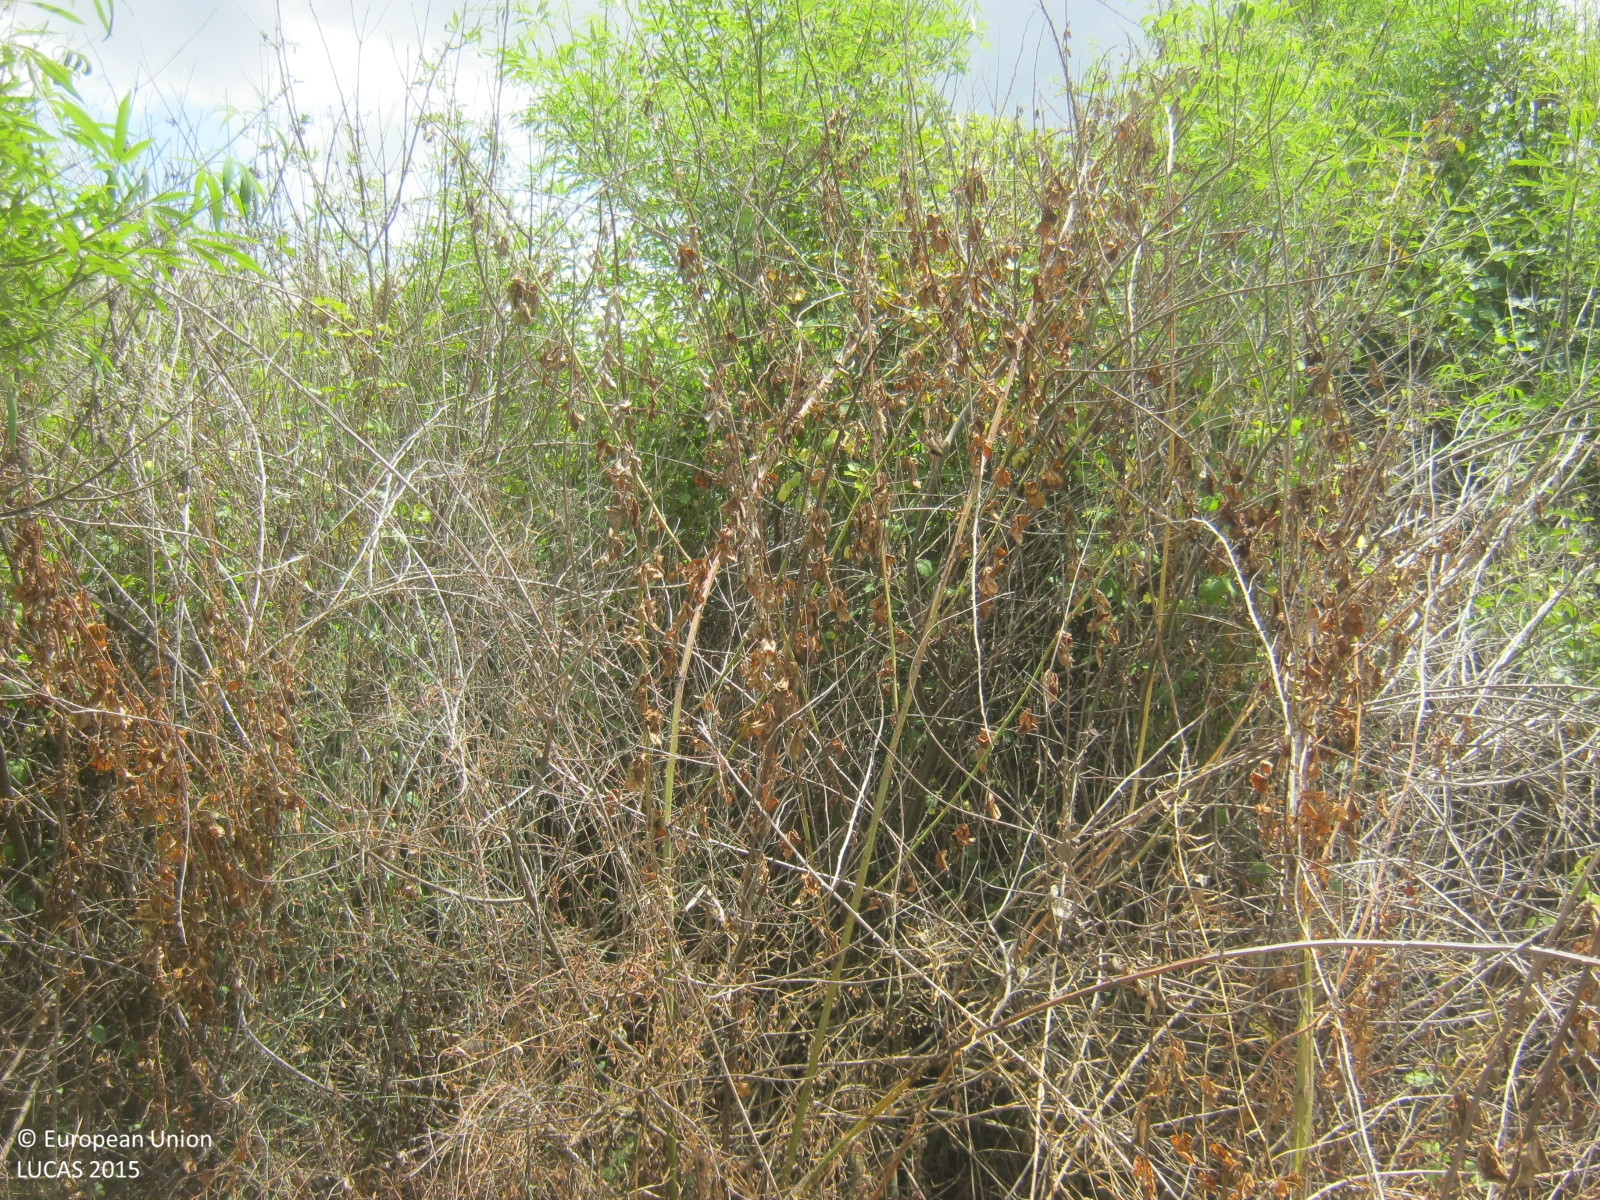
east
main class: Cropland
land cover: Olive groves
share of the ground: 50 - 75 %
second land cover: Grassland without tree/shrub cover
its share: > 75 %
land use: Abandoned areas
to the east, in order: Olive groves; Grassland without tree/shrub cover; Rivers and streams; Artificial constructions; Shrubland with sparse tree cover; Other bare soil; Olive groves; Ditches and canals; Olive groves; Artificial constructions in urban areas; Other bare soil; Tracks; Common wheat
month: June
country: CY
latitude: 35.0452
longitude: 32.8972
